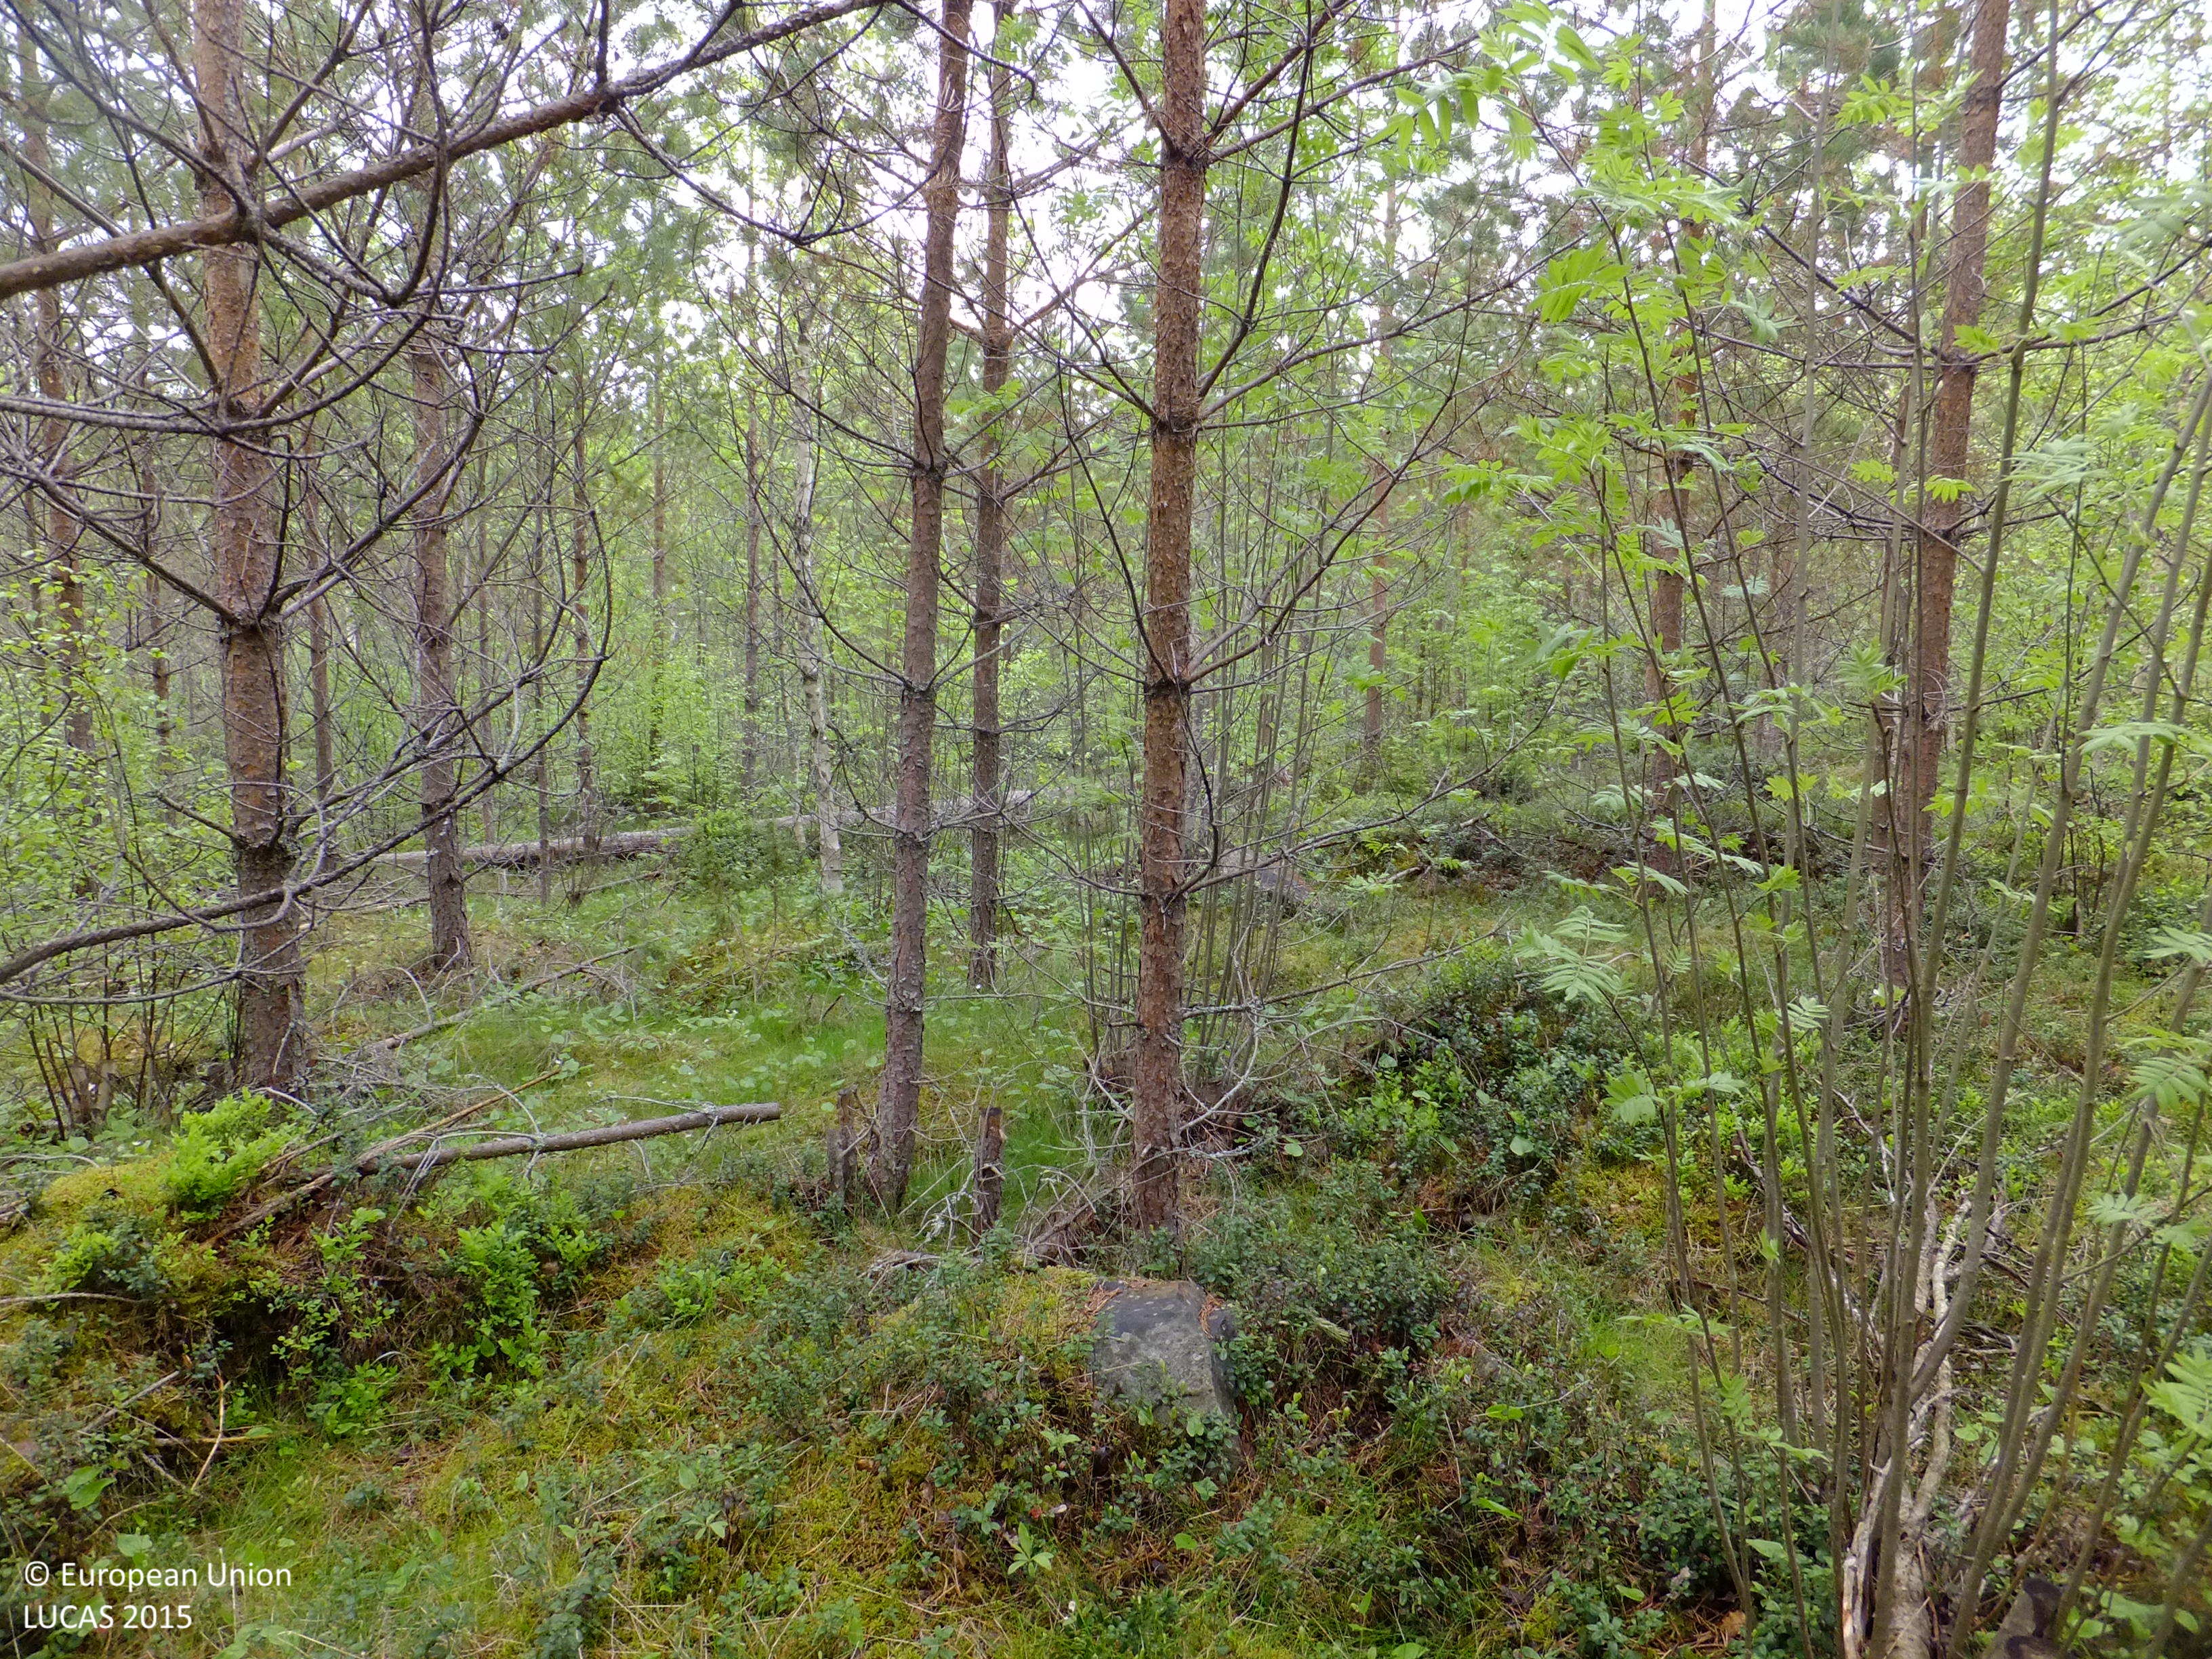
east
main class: Woodland
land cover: Pine dominated mixed woodland
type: boreal forest
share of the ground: > 75 %
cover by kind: coniferous forest trees 55 %, broadleaved forest trees 20 %, herbaceous plants 15 %, shrubs 10 %
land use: Forestry
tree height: < 5 m
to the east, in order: Pine dominated mixed woodland; Artificial constructions in urban areas; Pine dominated coniferous woodland; Inland fresh water bodies; Inland marshes
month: June
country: FI
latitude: 63.4621
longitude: 23.1569
